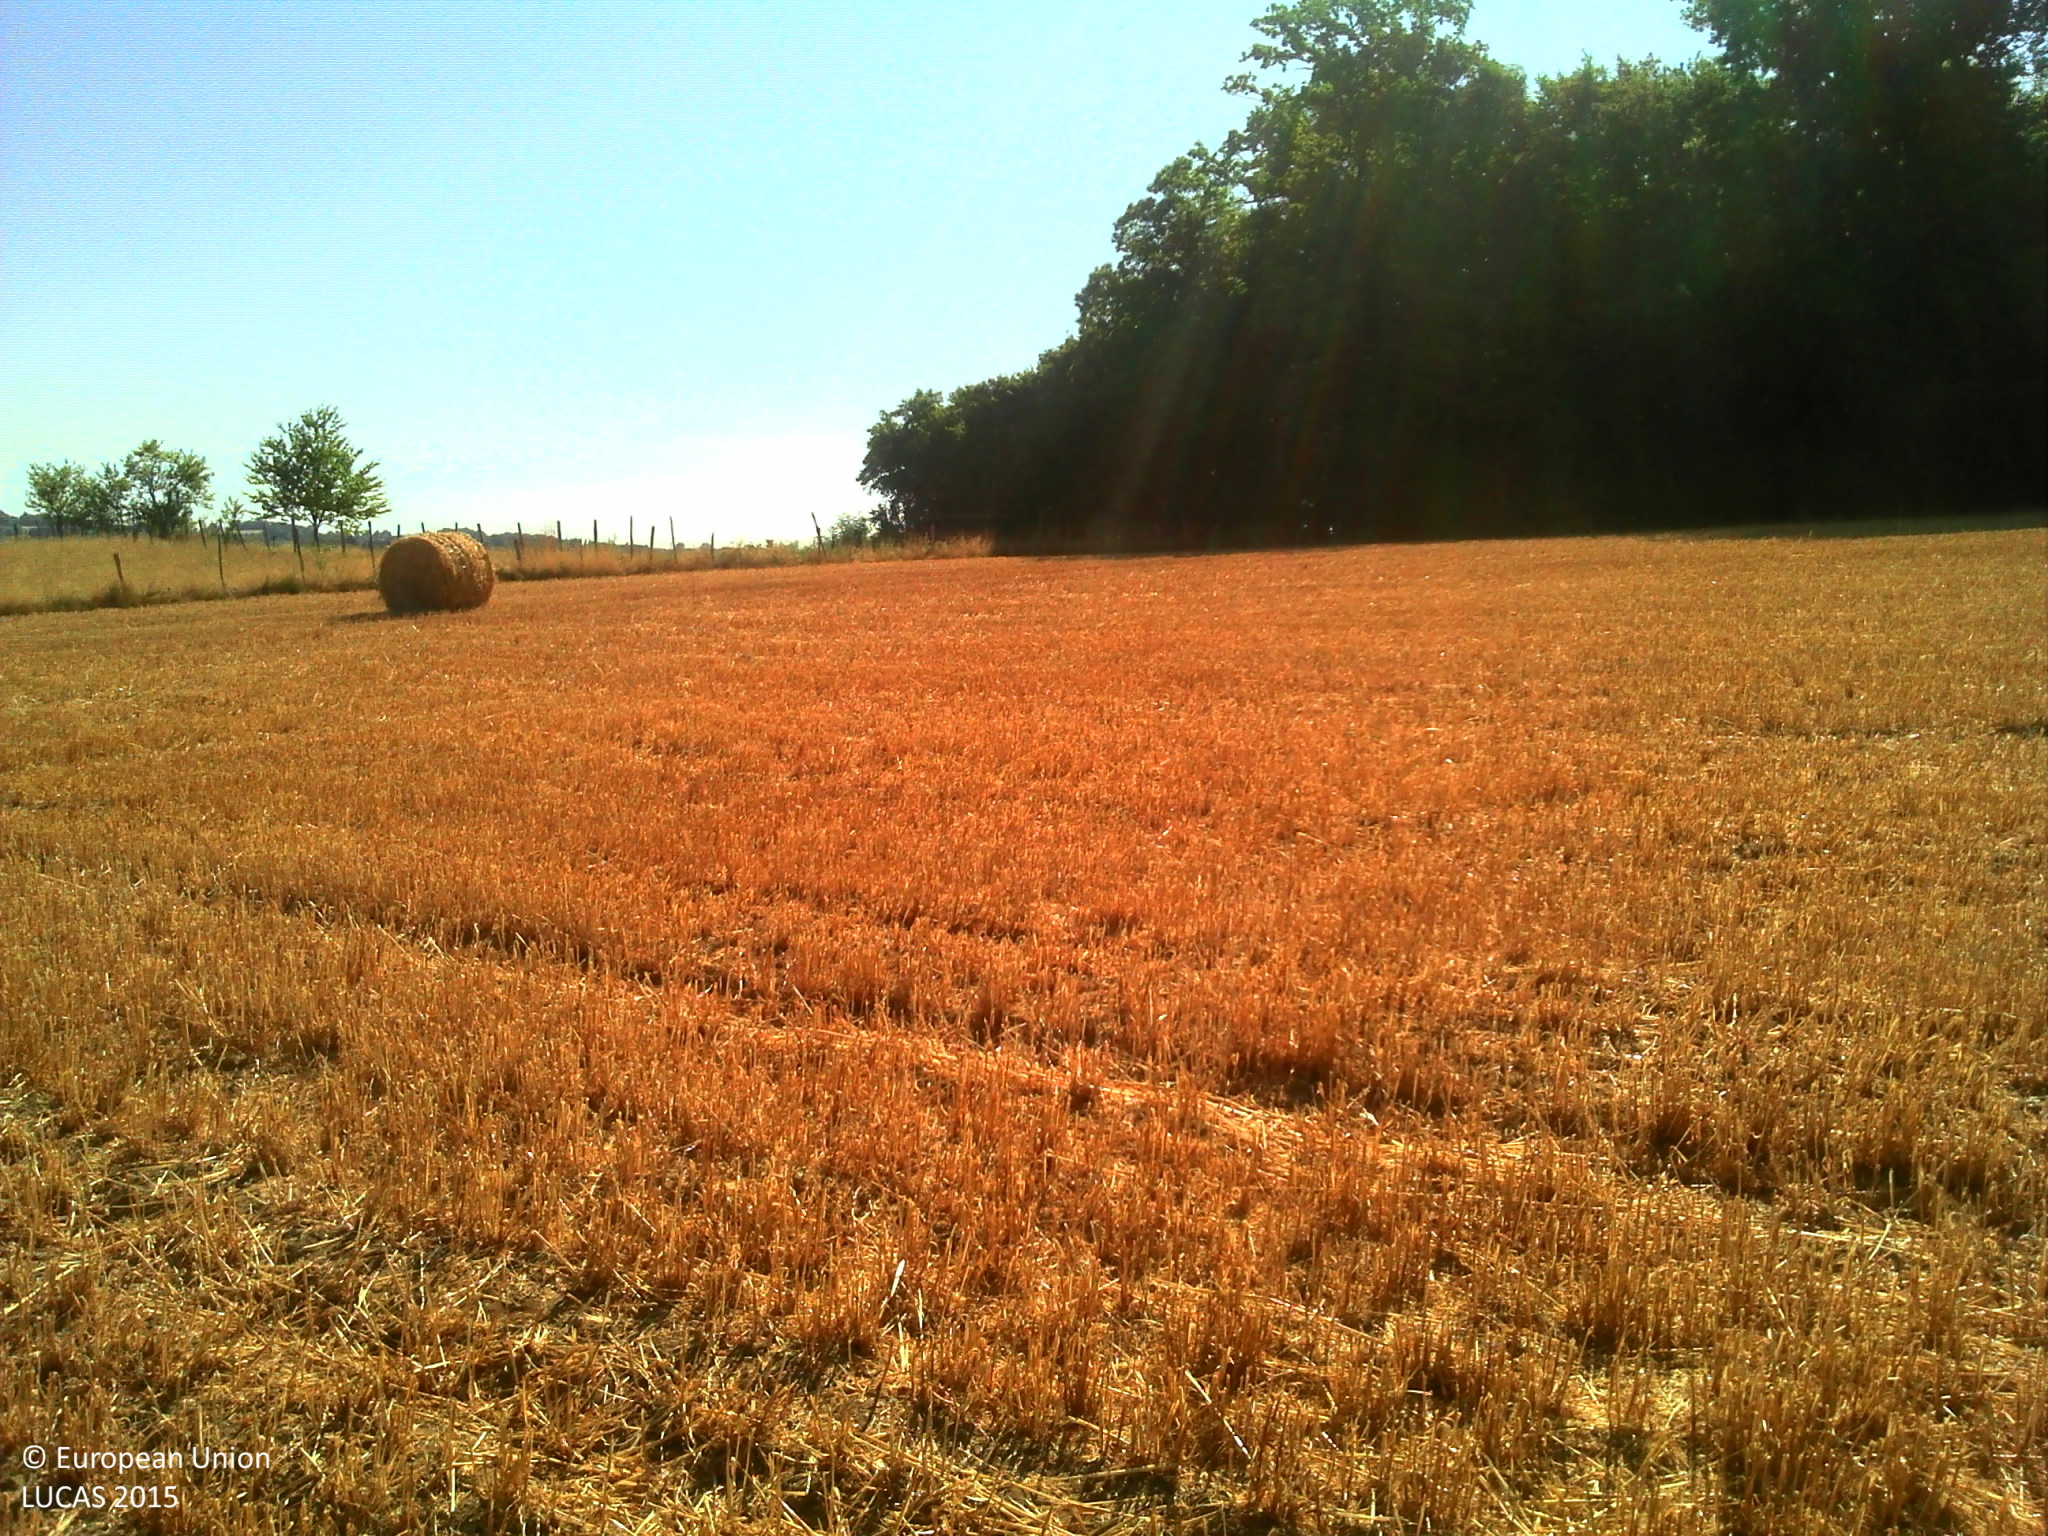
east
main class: Cropland
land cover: Durum wheat
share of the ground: > 75 %
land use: Agriculture (excluding fallow land and kitchen gardens)
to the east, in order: Durum wheat; Fences; Broadleaved woodland; Fences; Tracks; Broadleaved woodland; Fences; Grassland without tree/shrub cover; Fences; Groves; Grassland without tree/shrub cover
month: July
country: FR
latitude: 45.6112
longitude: 1.4657
